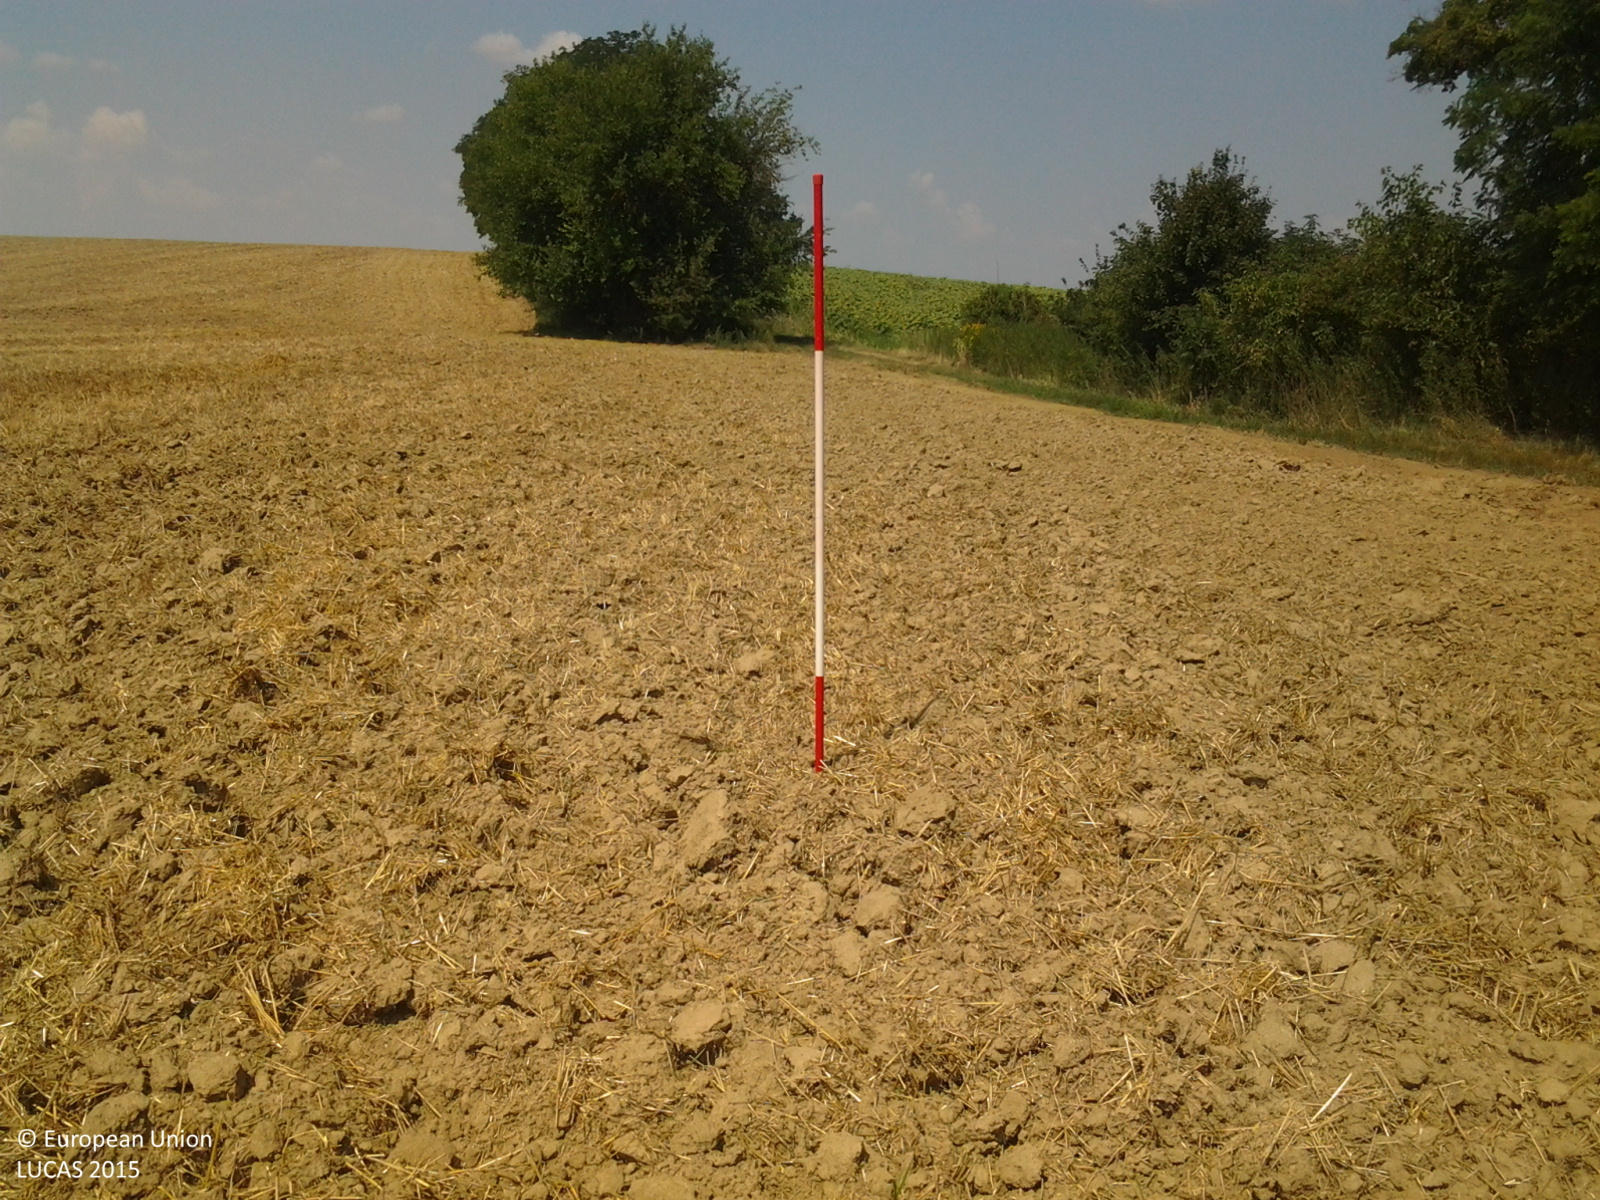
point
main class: Cropland
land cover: Triticale
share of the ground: < 10 %
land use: Agriculture (excluding fallow land and kitchen gardens)
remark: Harvested field
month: August
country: HU
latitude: 46.4505
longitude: 18.2231
